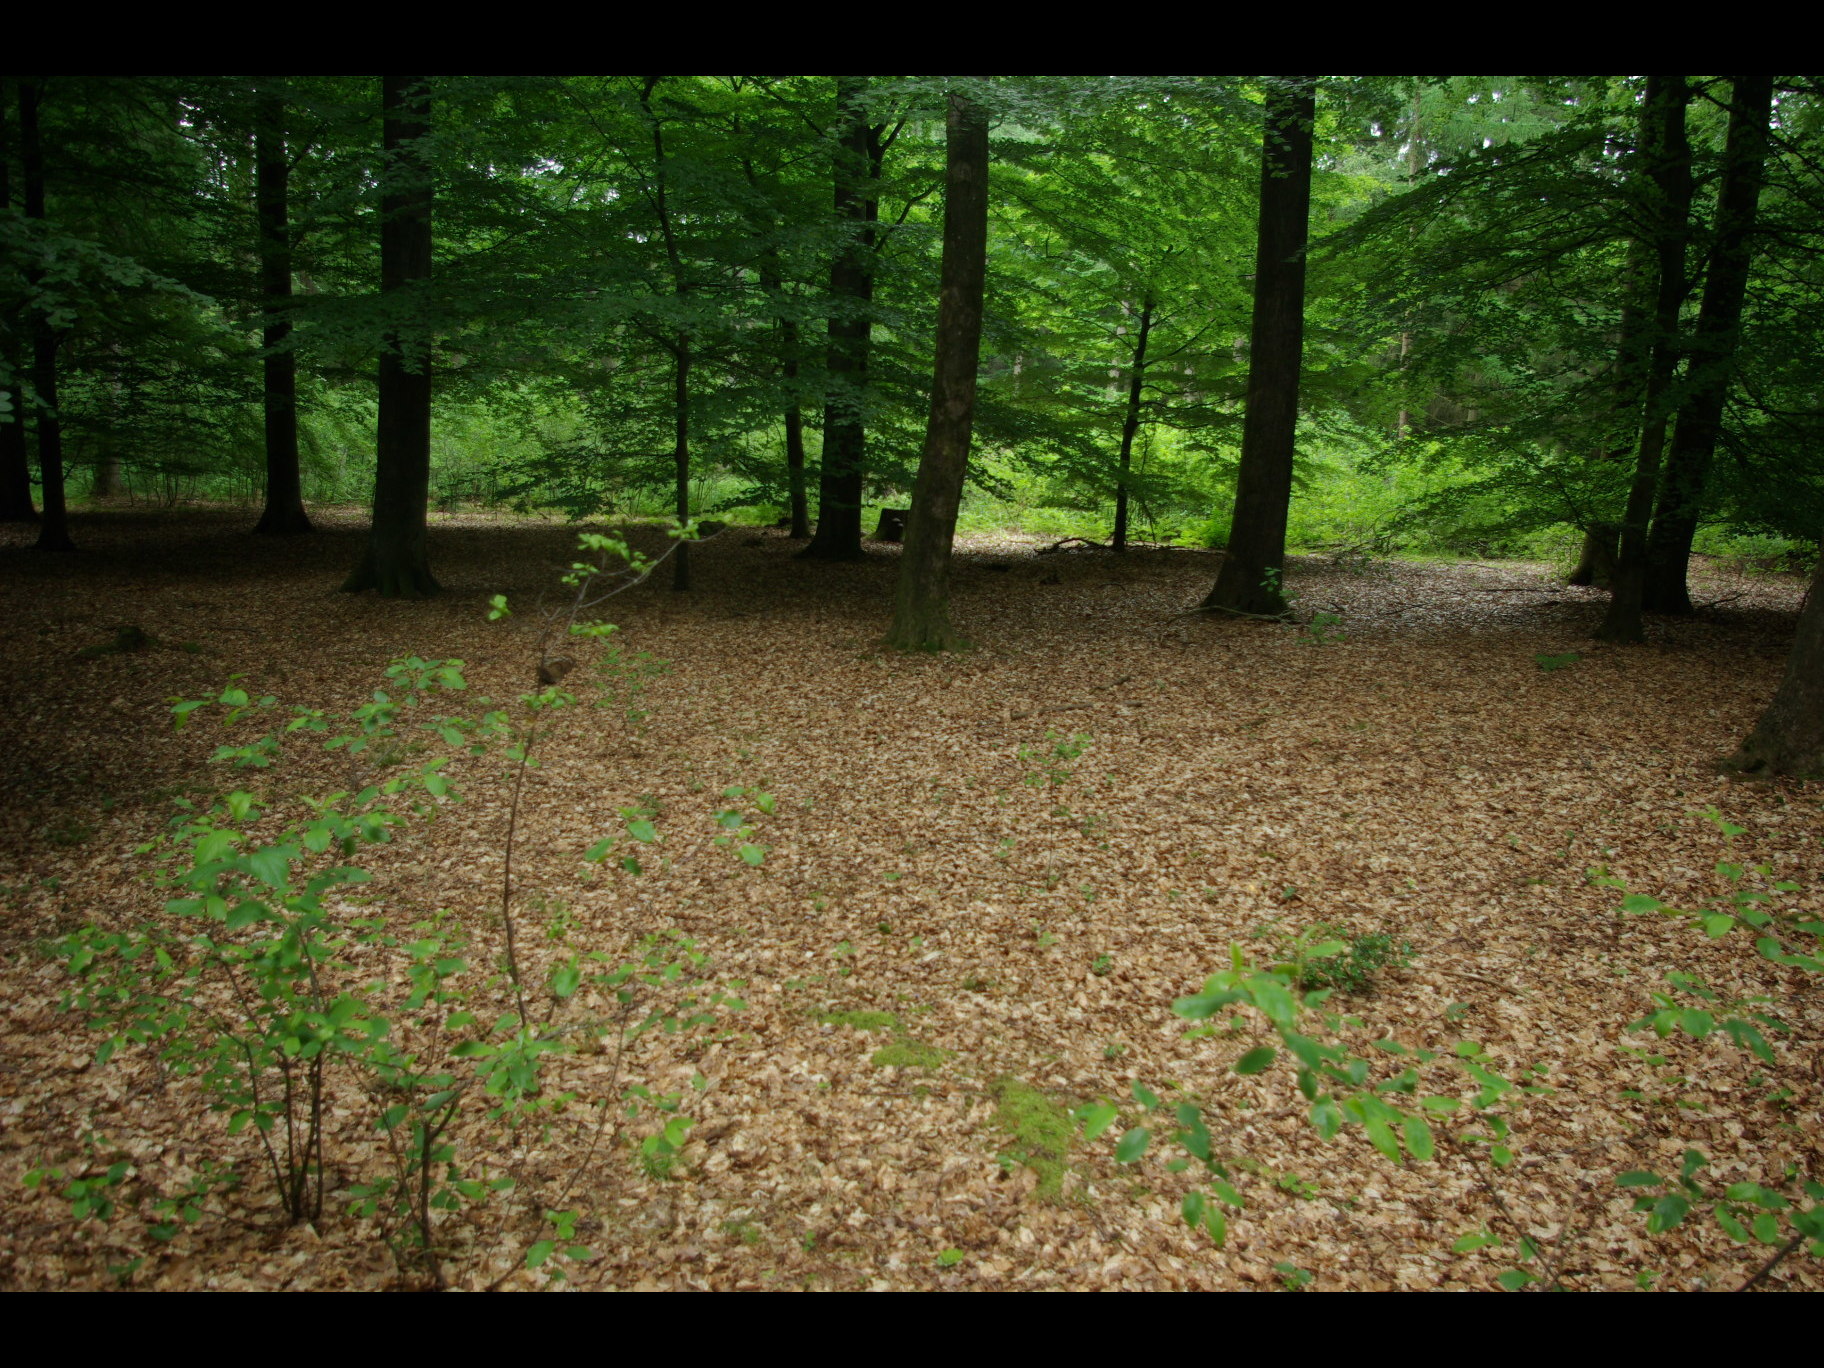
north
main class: Woodland
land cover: Broadleaved woodland
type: beech forest
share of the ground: > 75 %
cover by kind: broadleaved forest trees 80 %, unconsolidated bare surface 10 %, shrubs 5 %, herbaceous plants 5 %
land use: Forestry
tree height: > 5 m
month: June
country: DE
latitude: 54.0664
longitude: 9.6488
